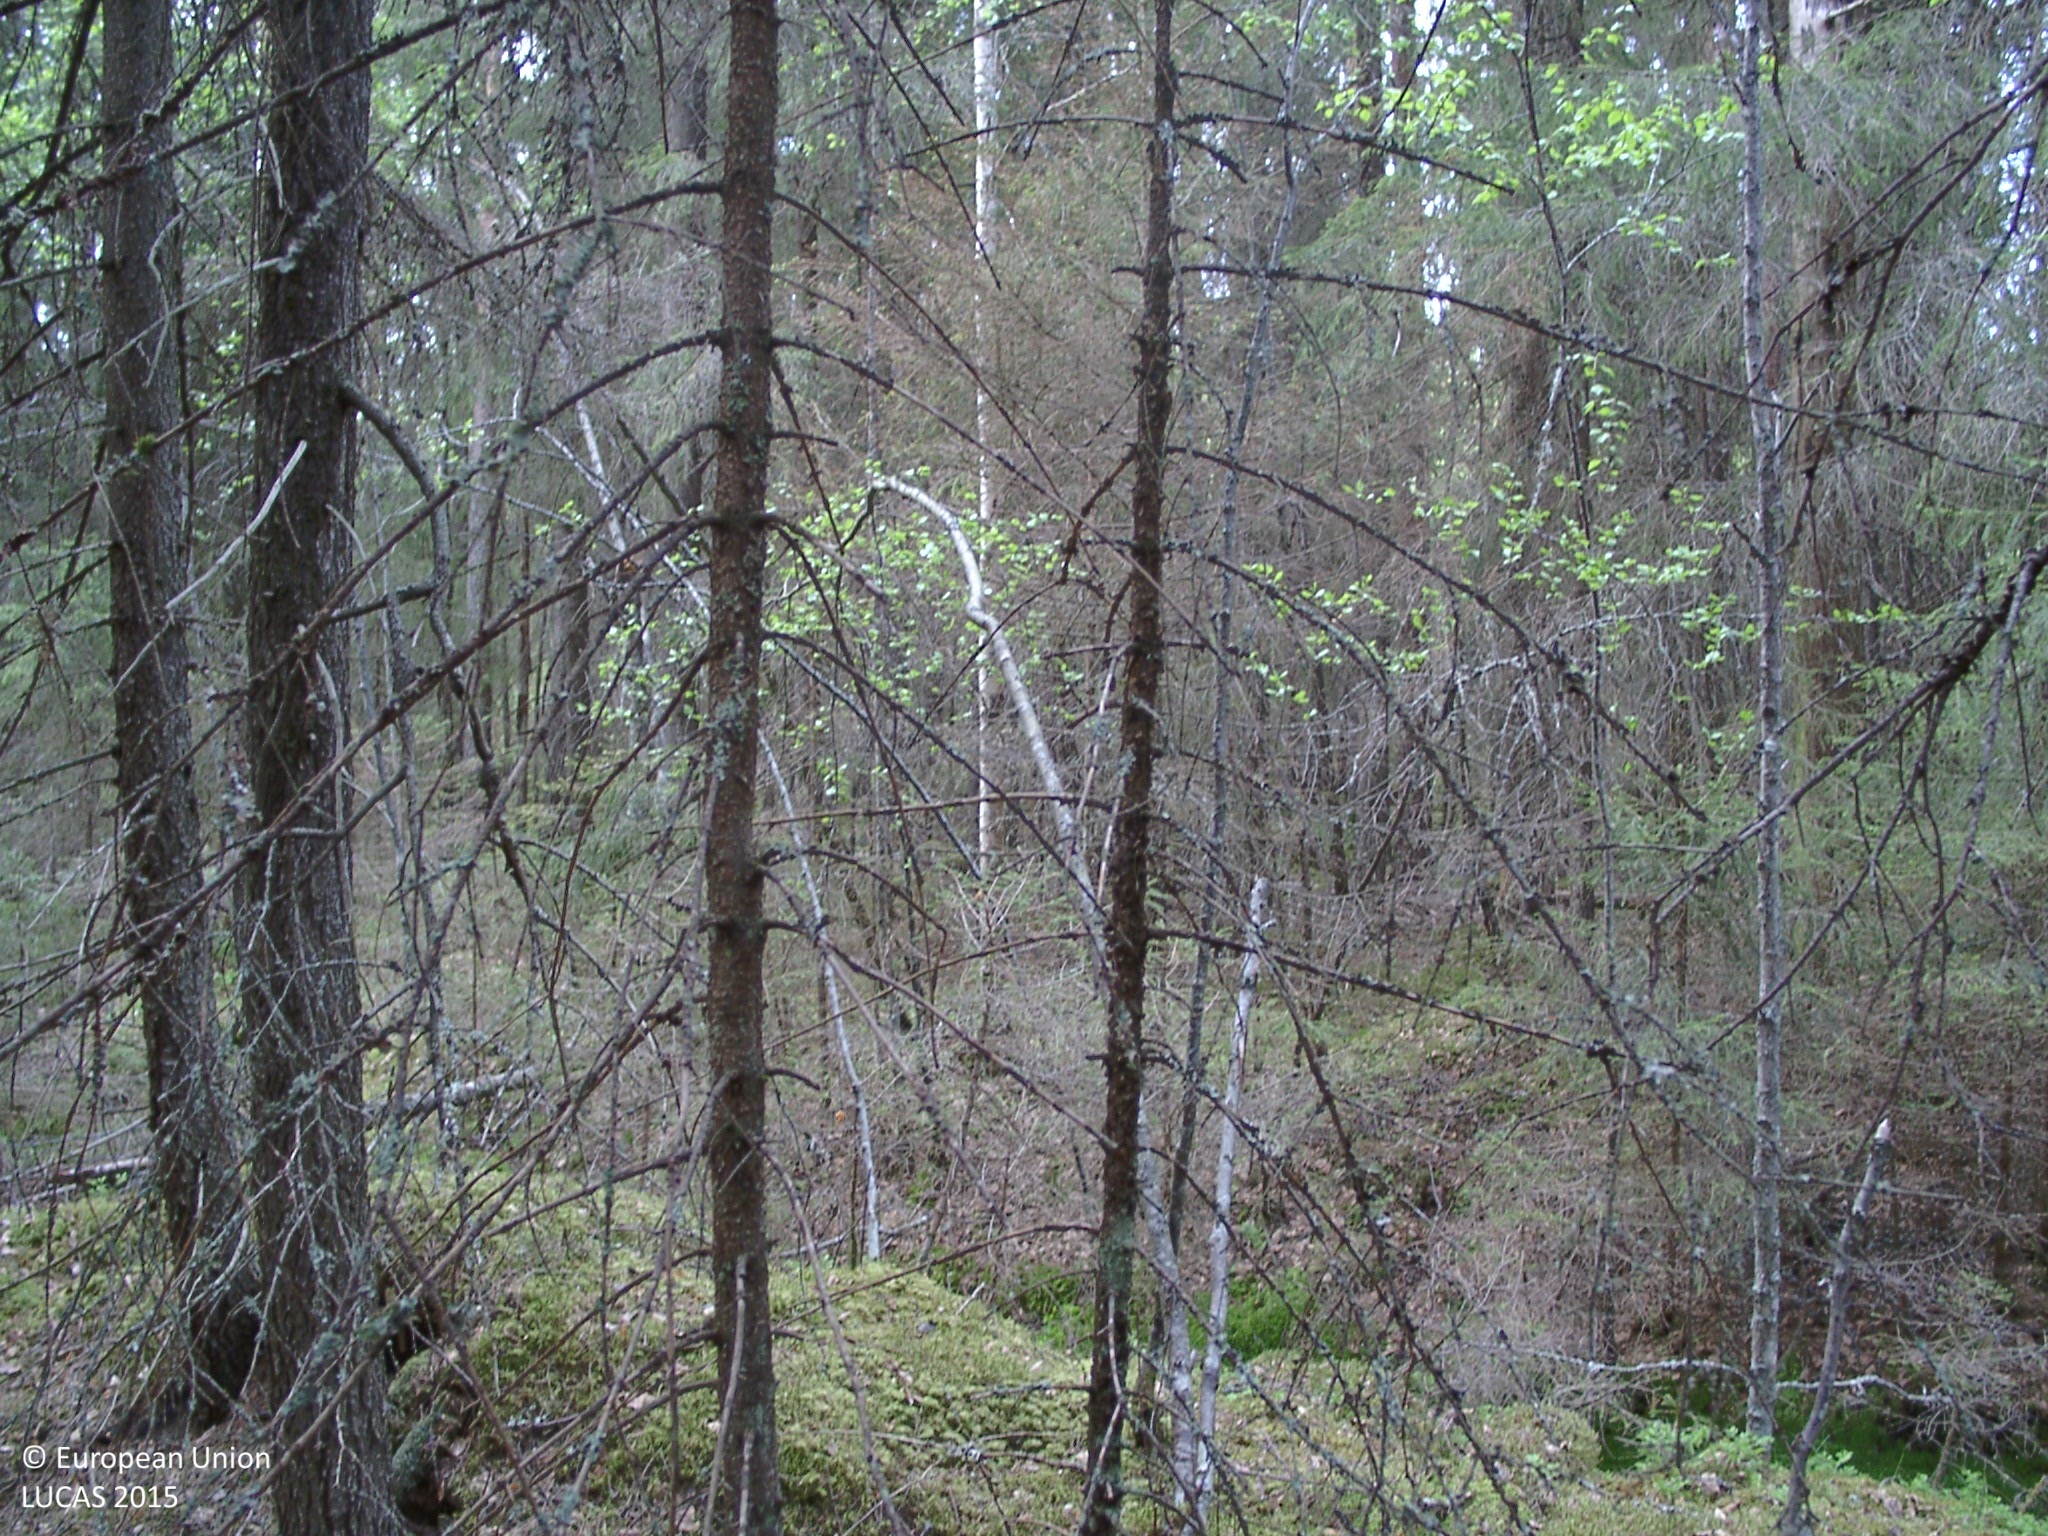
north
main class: Woodland
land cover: Other coniferous woodland
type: boreal forest
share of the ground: > 75 %
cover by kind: coniferous forest trees 70 %, lichens and mosses 15 %, shrubs 10 %, broadleaved forest trees 5 %
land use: Semi-natural and natural areas not in use
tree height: > 5 m
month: June
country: FI
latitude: 62.1230
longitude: 25.4315
